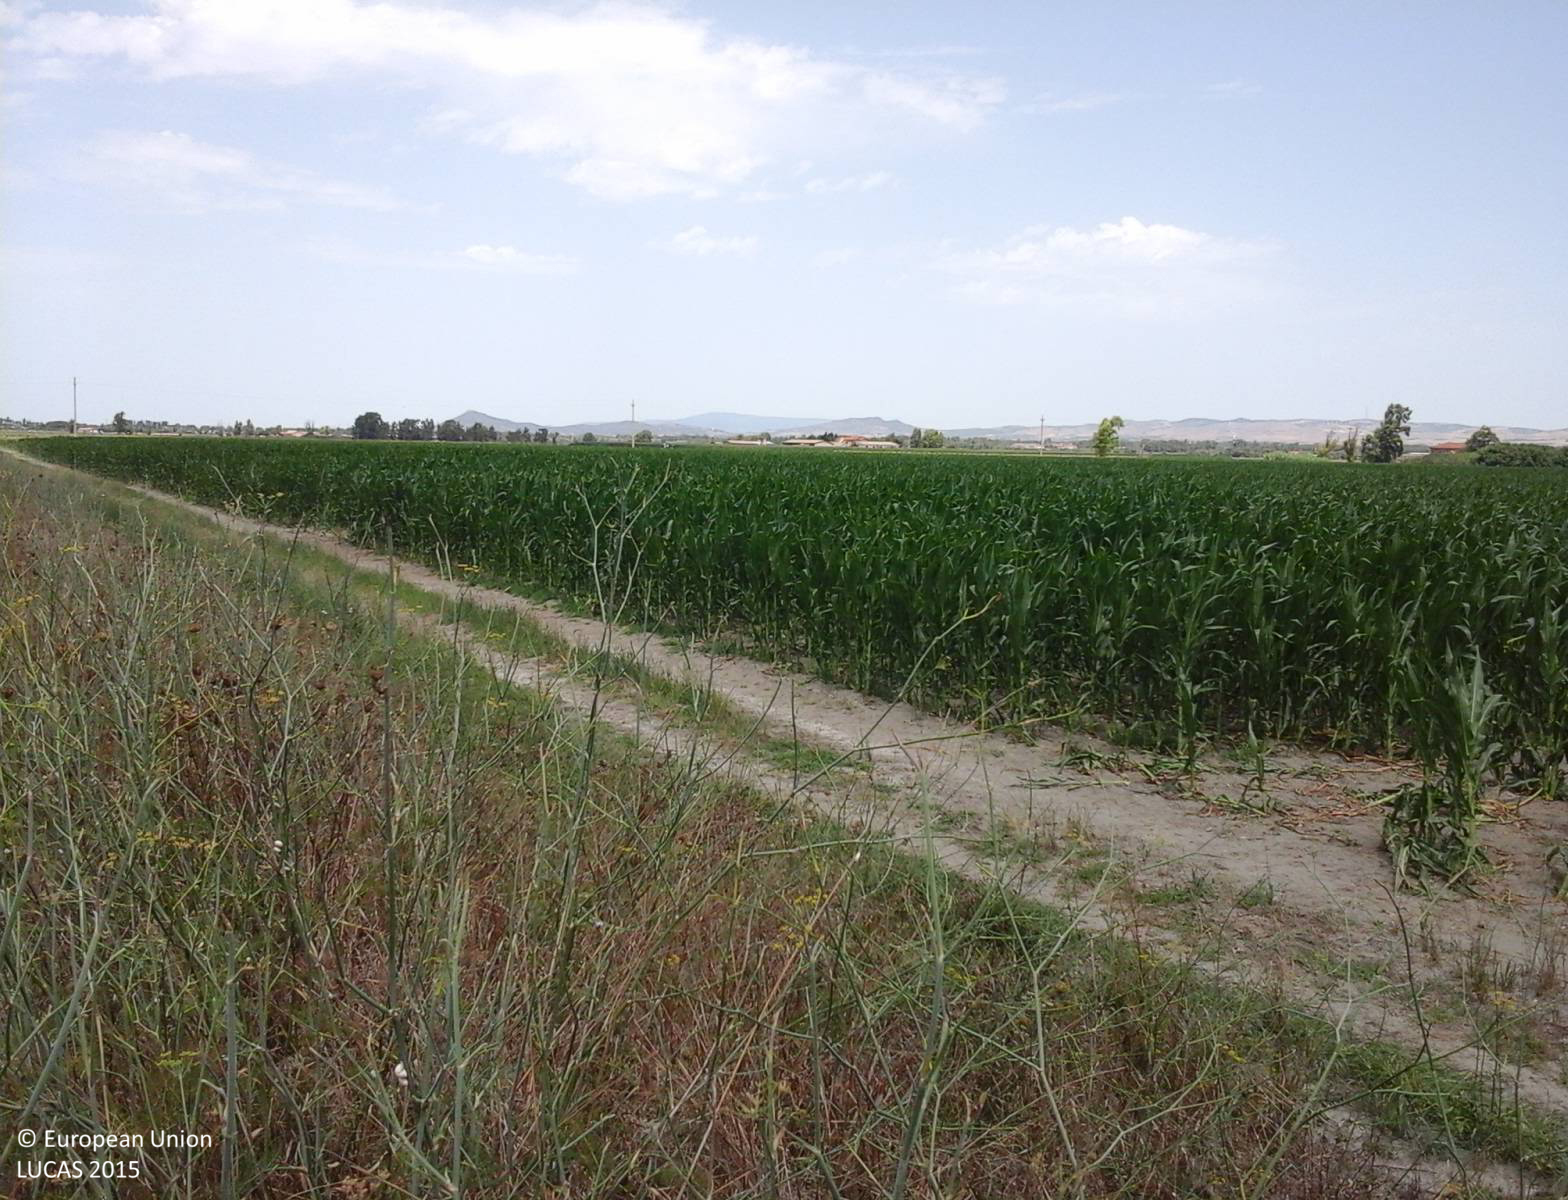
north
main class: Cropland
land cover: Maize
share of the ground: > 75 %
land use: Agriculture (excluding fallow land and kitchen gardens)
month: July
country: IT
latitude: 39.5000
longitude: 8.8555
